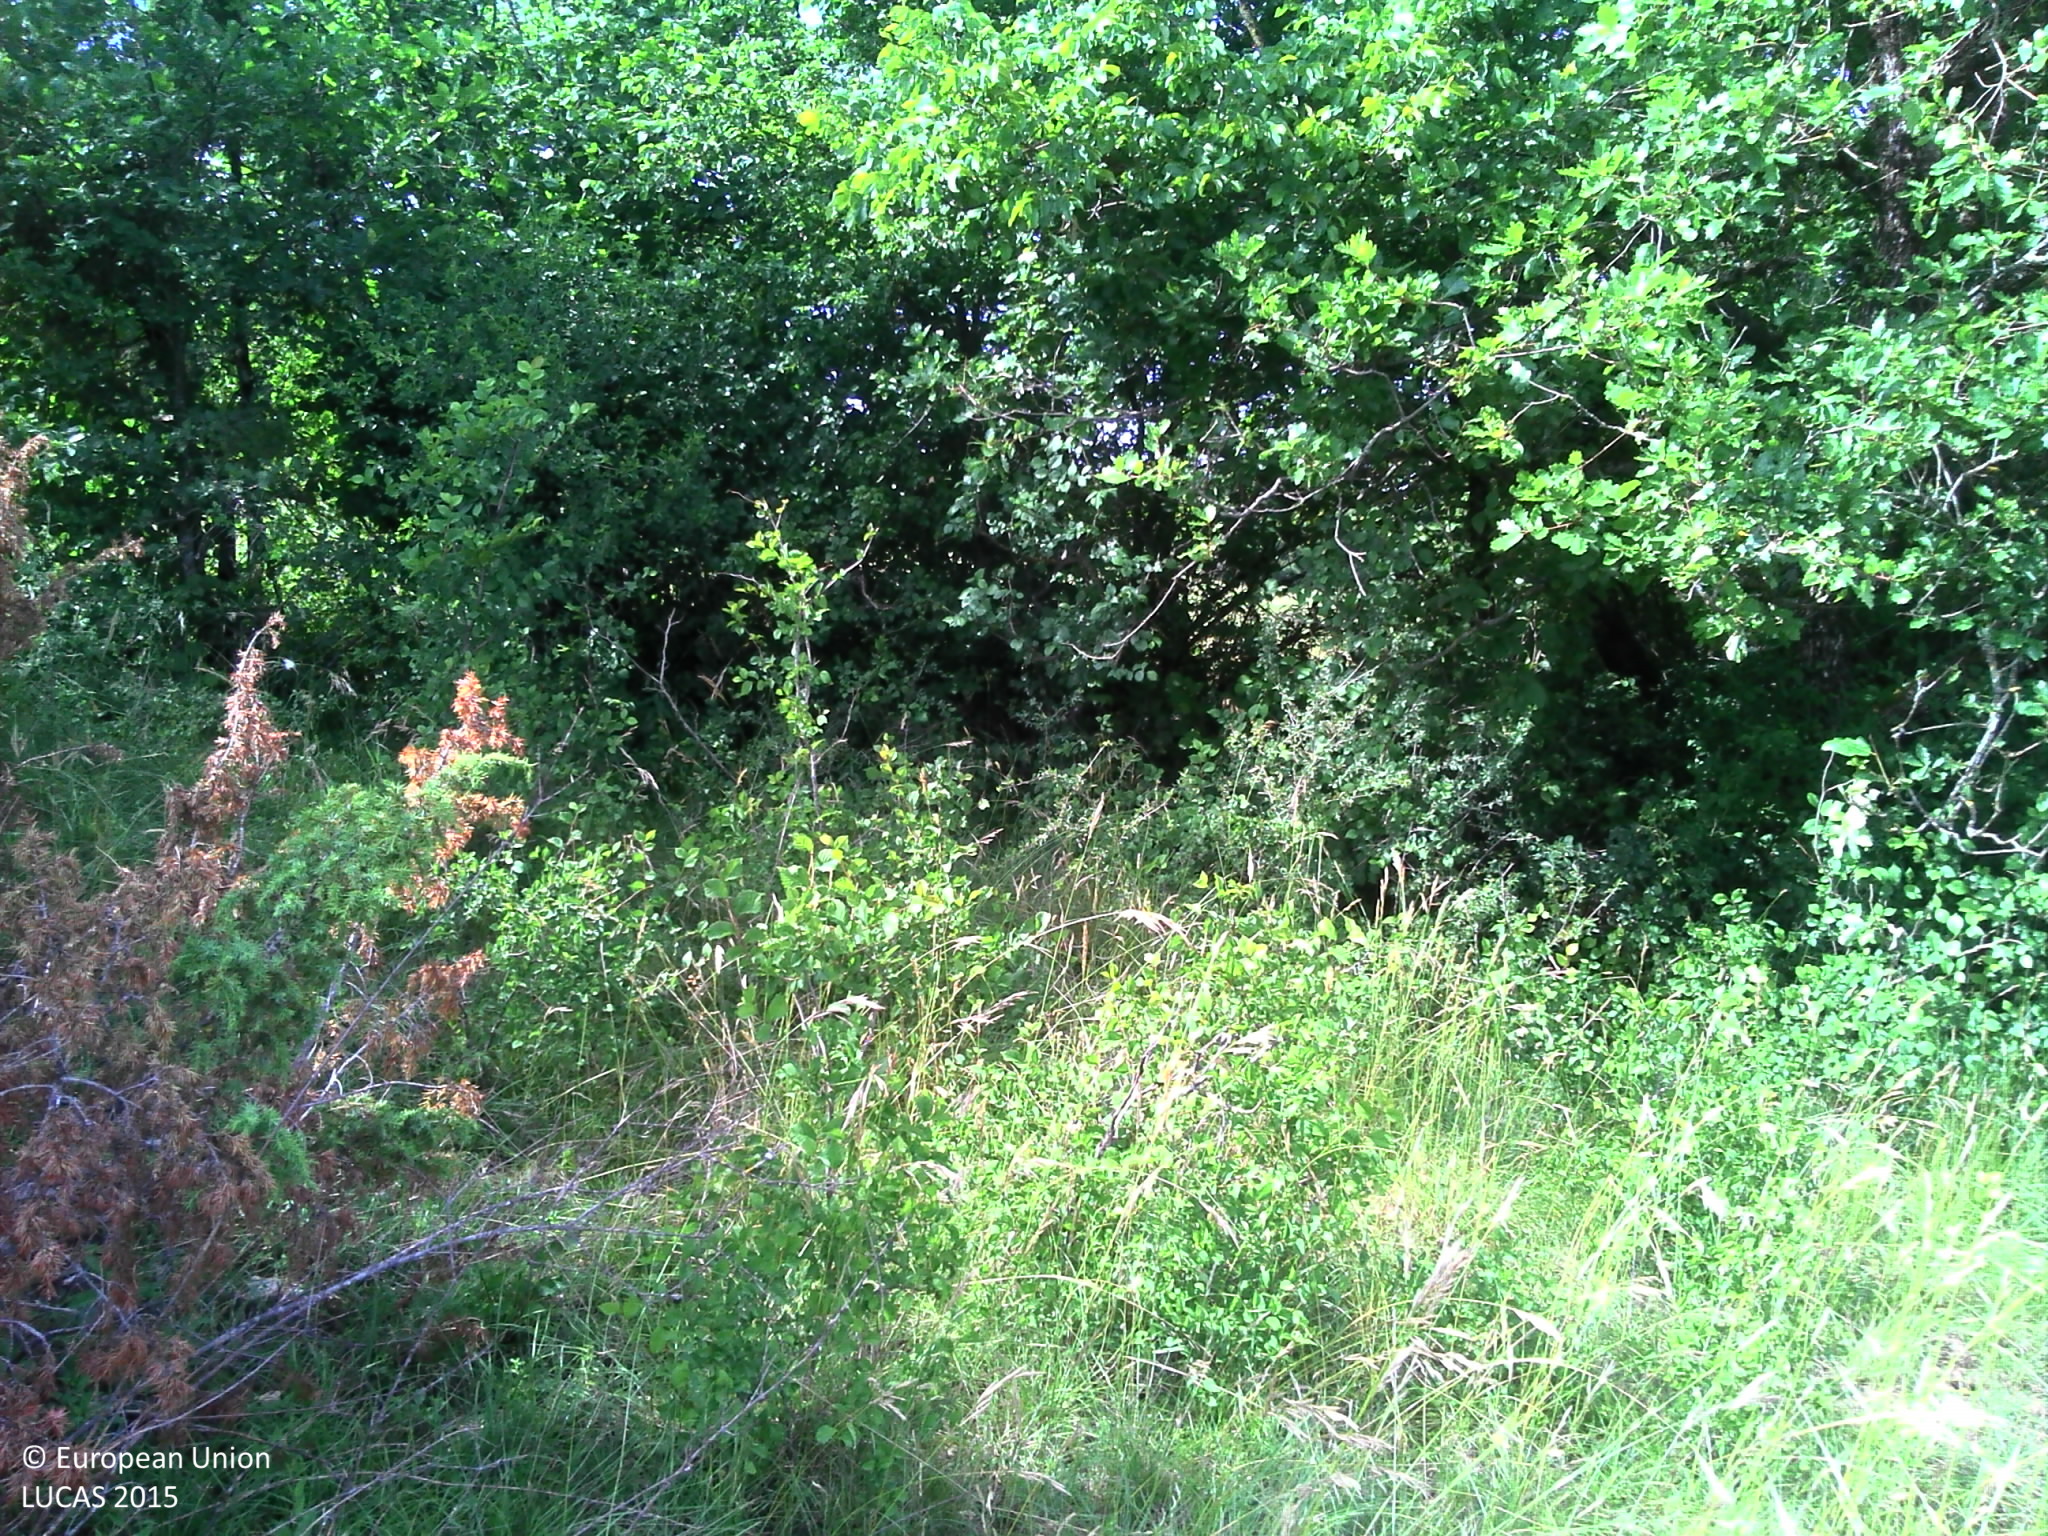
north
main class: Grassland
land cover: Grassland with sparse tree/shrub cover
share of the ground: > 75 %
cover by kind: herbaceous plants 95 %, broadleaved forest trees 5 %
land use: Agriculture (excluding fallow land and kitchen gardens)
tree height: < 5 m
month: June
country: FR
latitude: 46.3601
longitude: 5.3889
